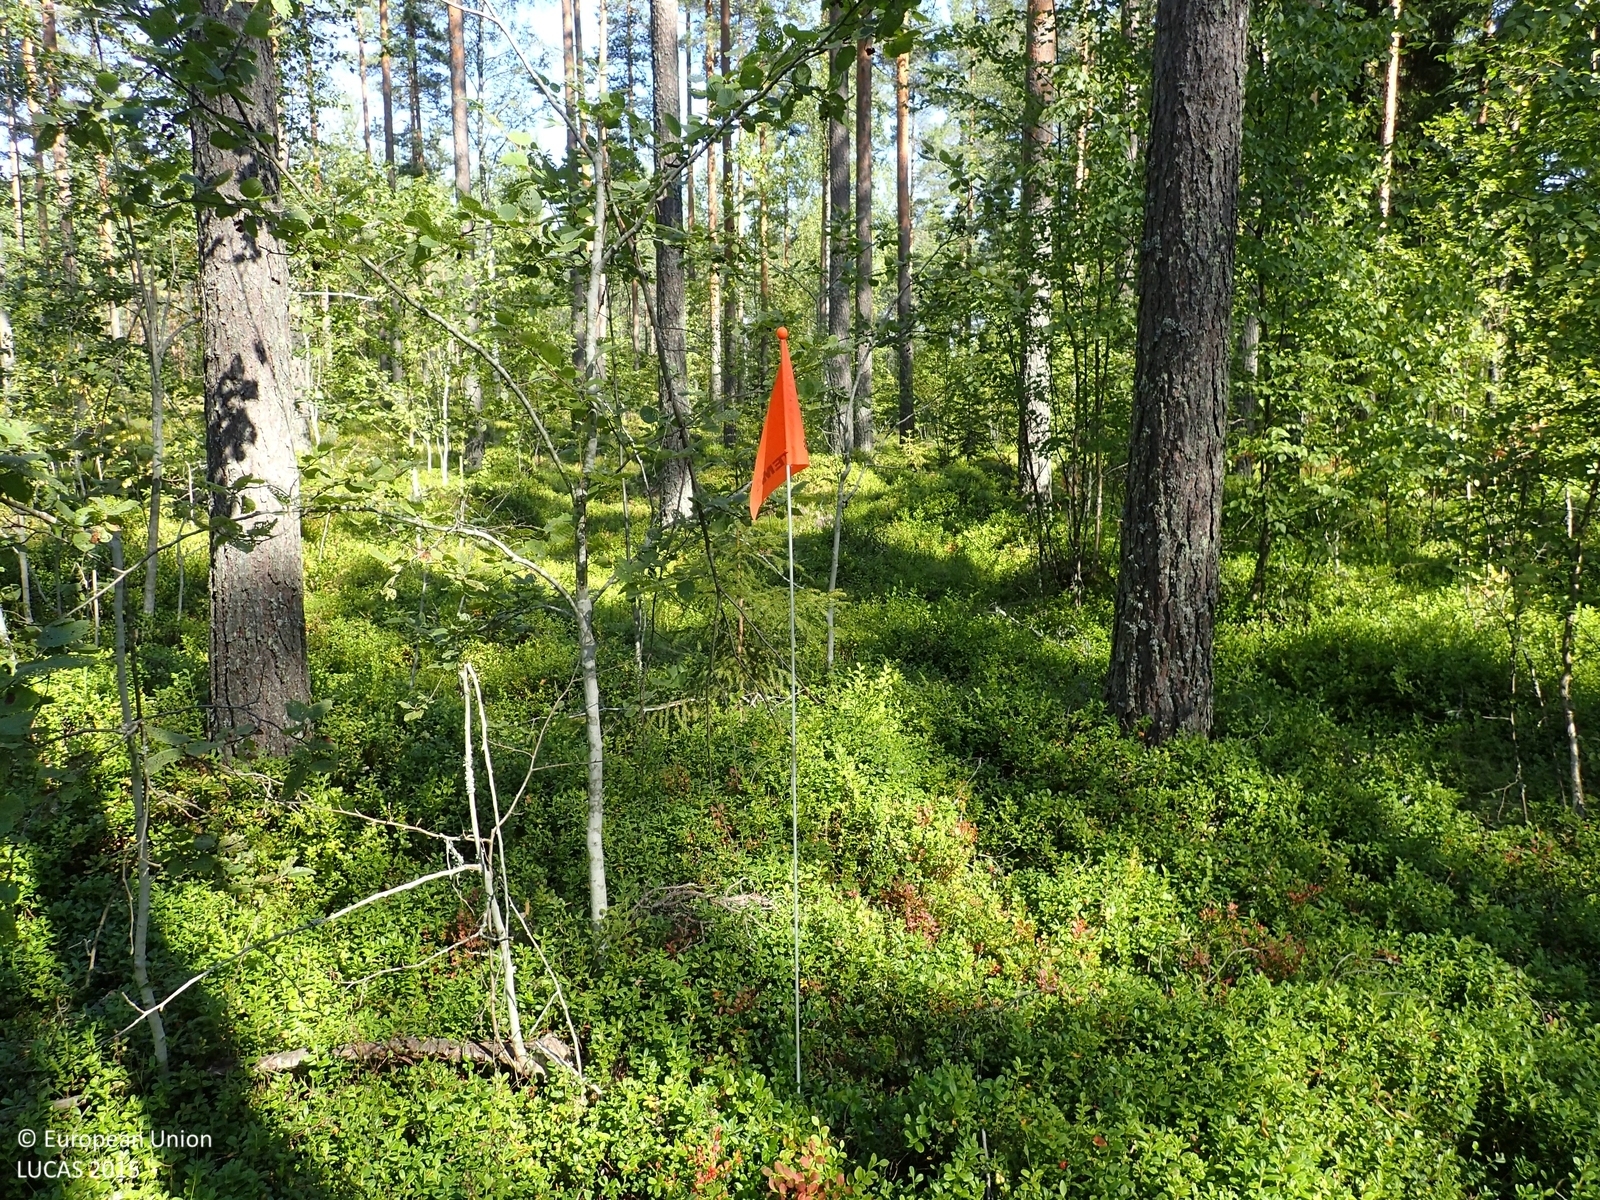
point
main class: Woodland
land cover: Pine dominated mixed woodland
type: boreal forest
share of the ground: 50 - 75 %
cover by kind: coniferous forest trees 45 %, shrubs 40 %, broadleaved forest trees 15 %
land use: Forestry
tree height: > 5 m
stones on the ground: < 10 %
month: August
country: FI
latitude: 62.3909
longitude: 21.9446
